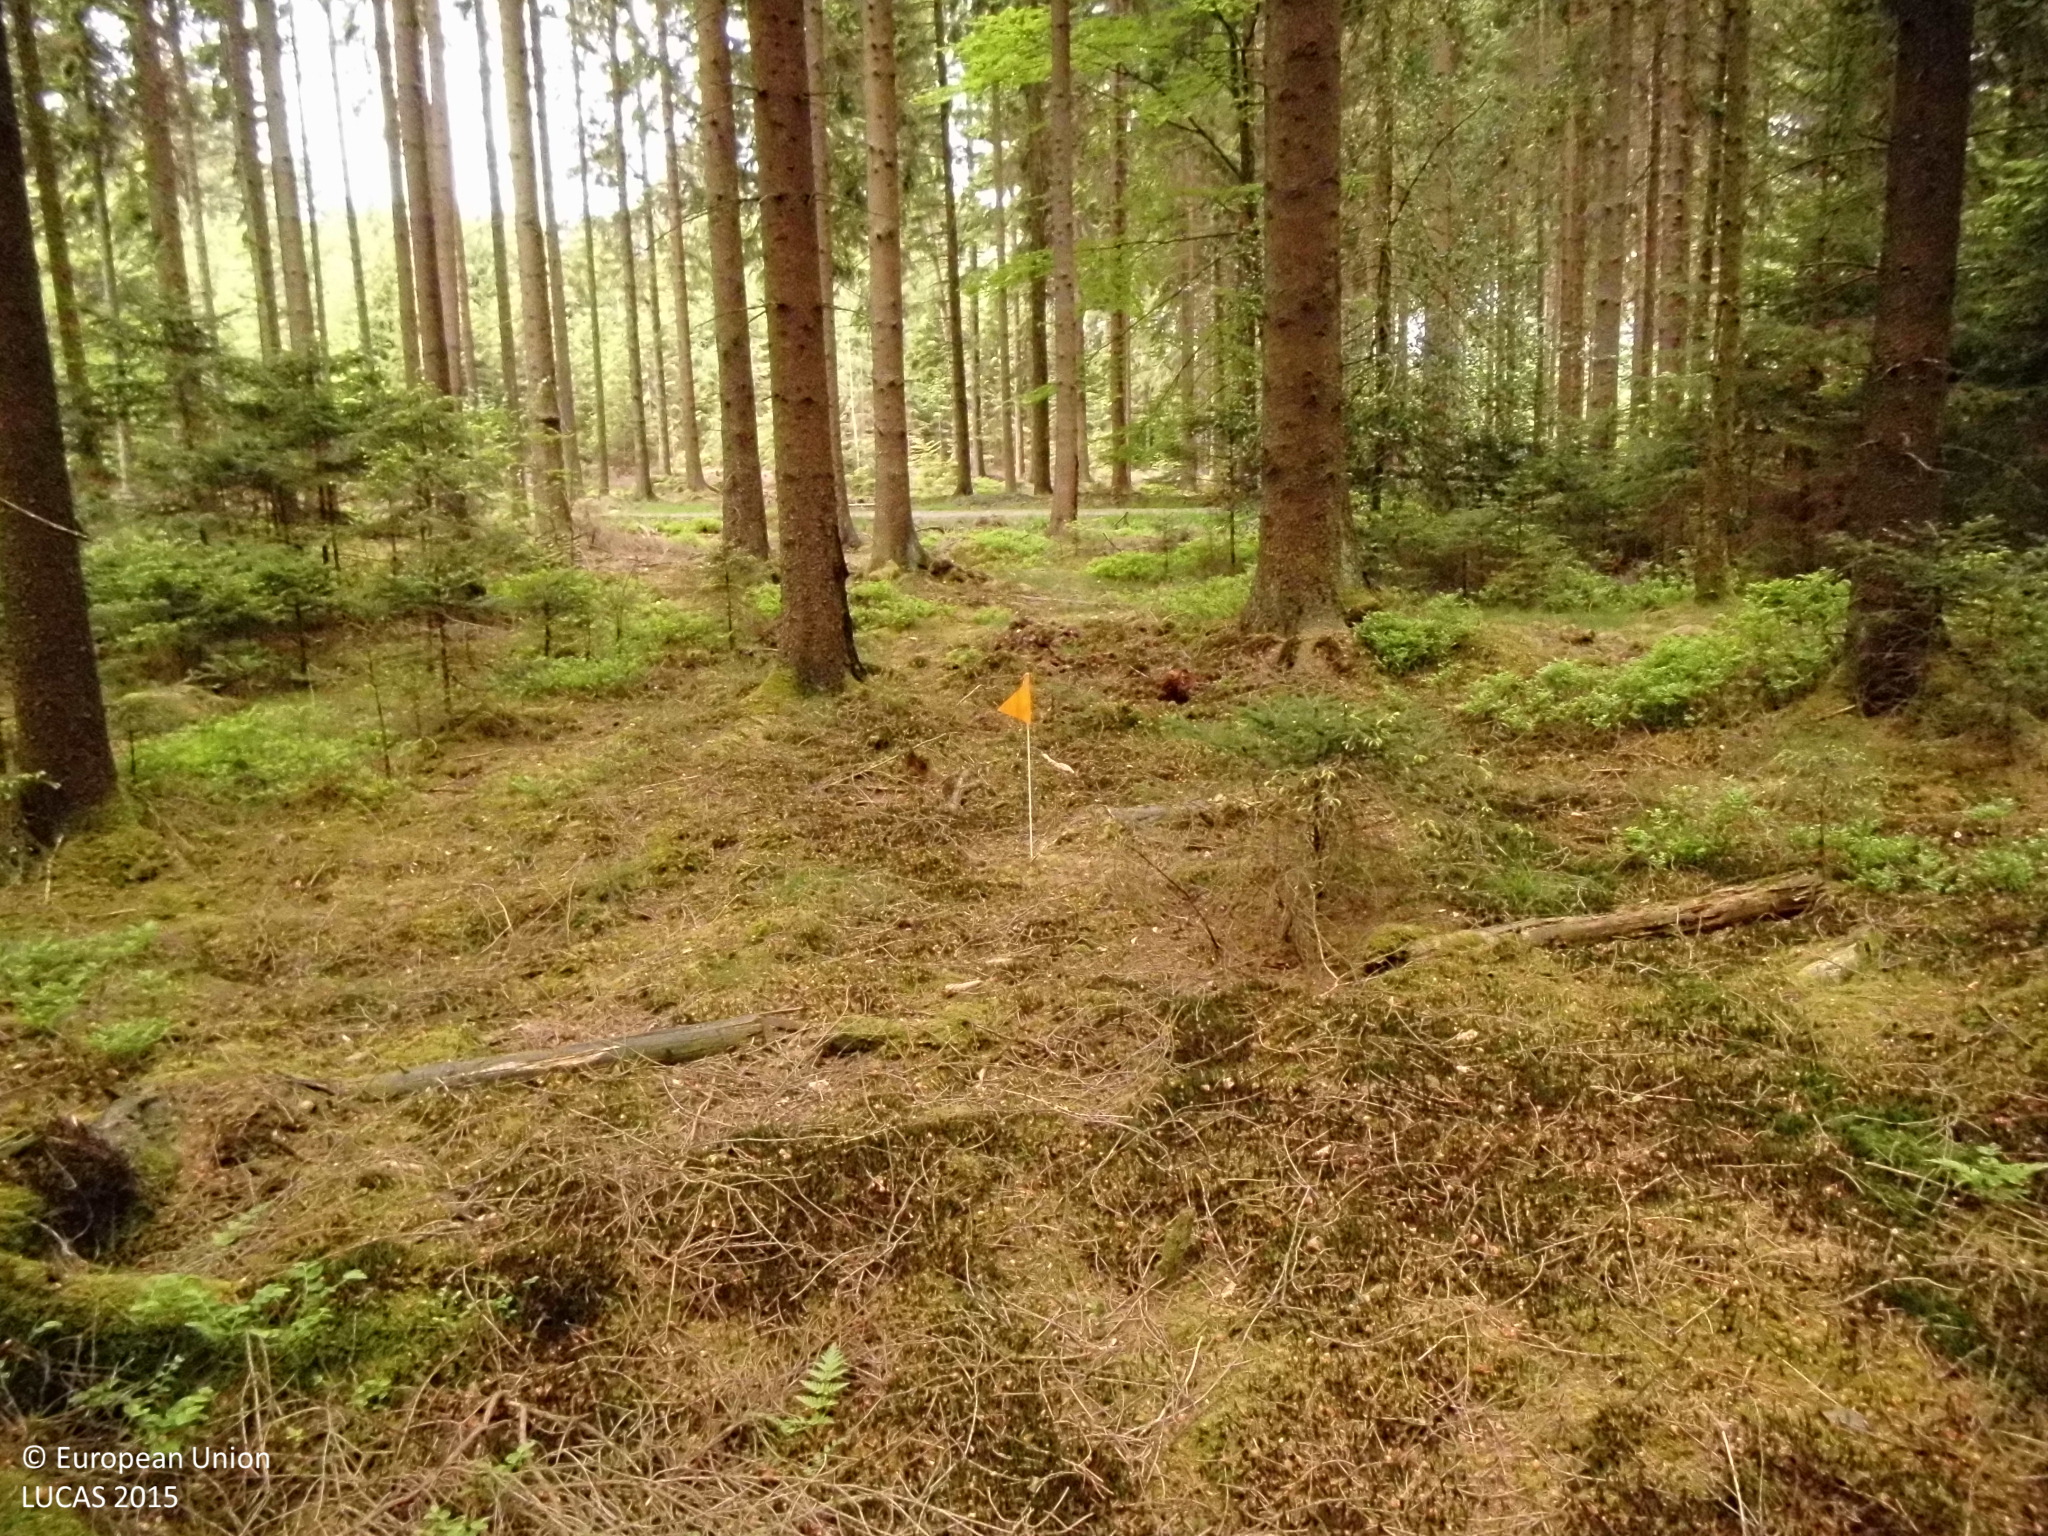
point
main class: Woodland
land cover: Spruce dominated coniferous woodland
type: hemiboreal forest and nemoral coniferous forest and mixed broadleaved-coniferous forest
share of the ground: > 75 %
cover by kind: coniferous forest trees 85 %, lichens and mosses 10 %, herbaceous plants 5 %
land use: Forestry
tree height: > 5 m
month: May
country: DE
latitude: 50.7330
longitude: 7.5208
